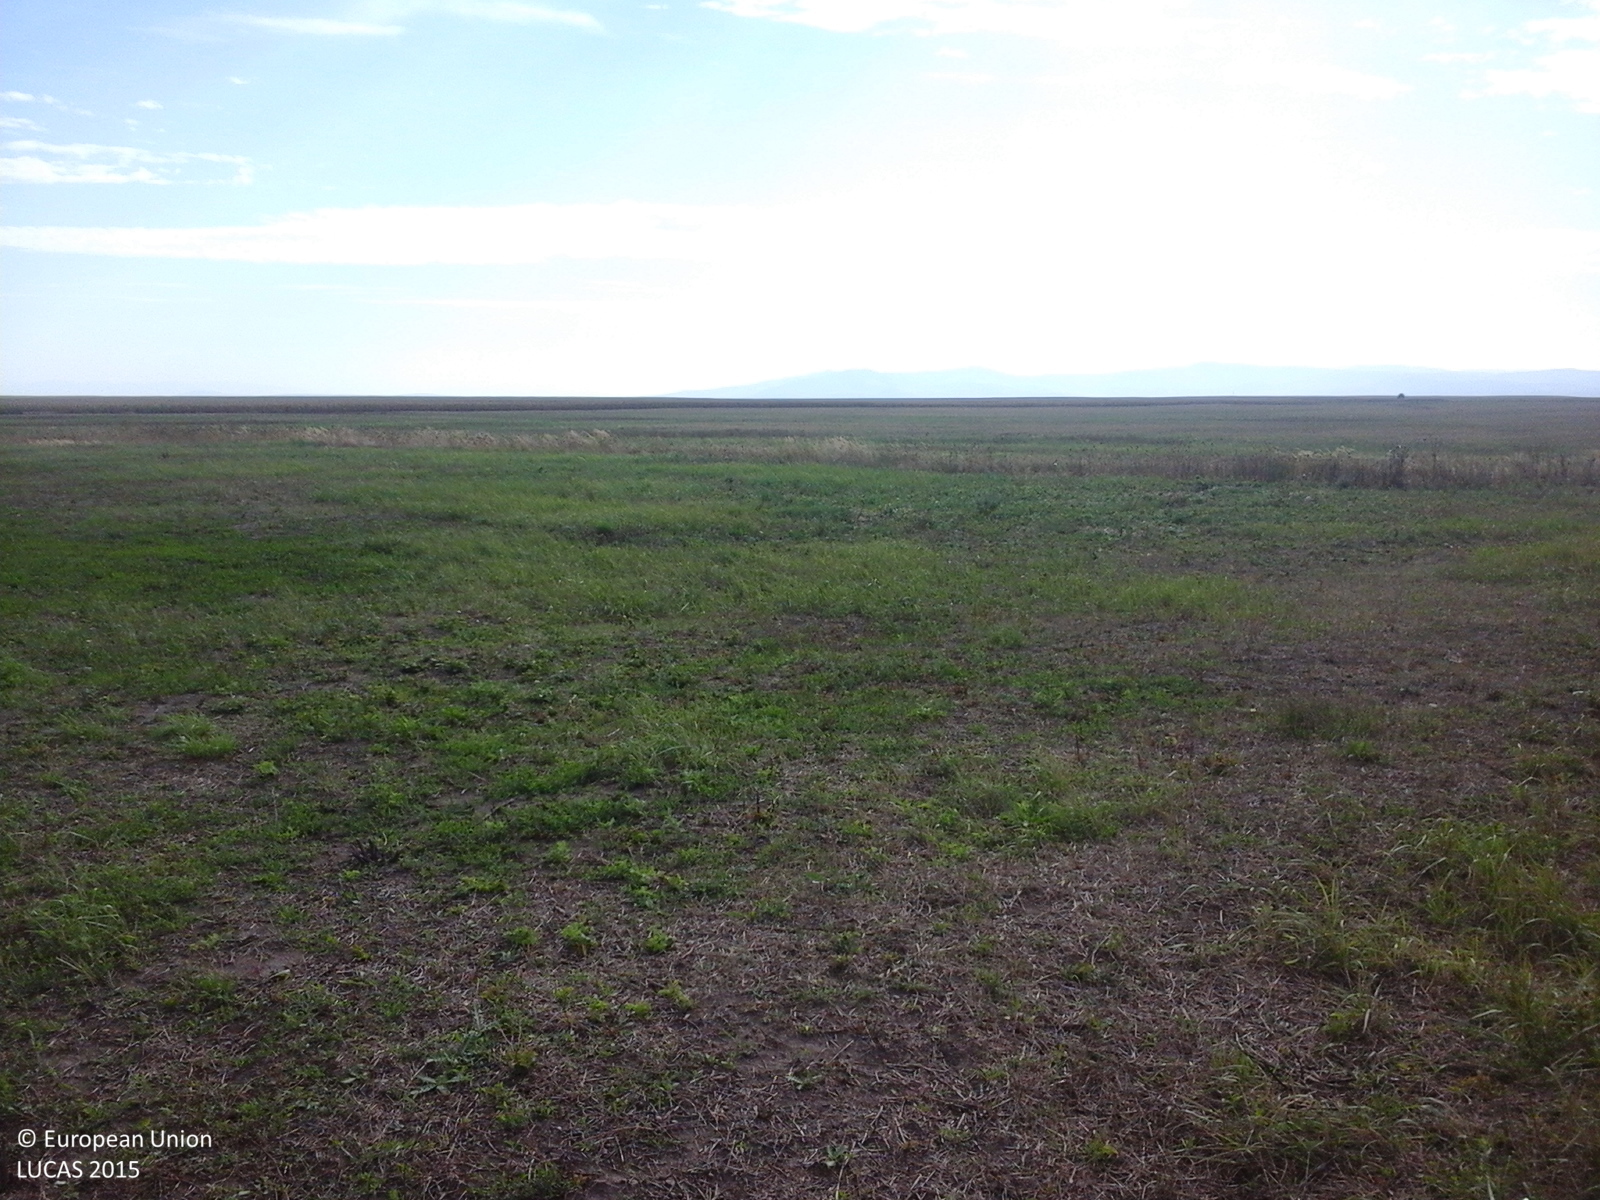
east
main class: Grassland
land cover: Grassland without tree/shrub cover
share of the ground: > 75 %
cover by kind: herbaceous plants 100 %
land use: Agriculture (excluding fallow land and kitchen gardens)
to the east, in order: Grassland without tree/shrub cover; Common wheat
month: August
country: RO
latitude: 46.2626
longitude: 21.4399
